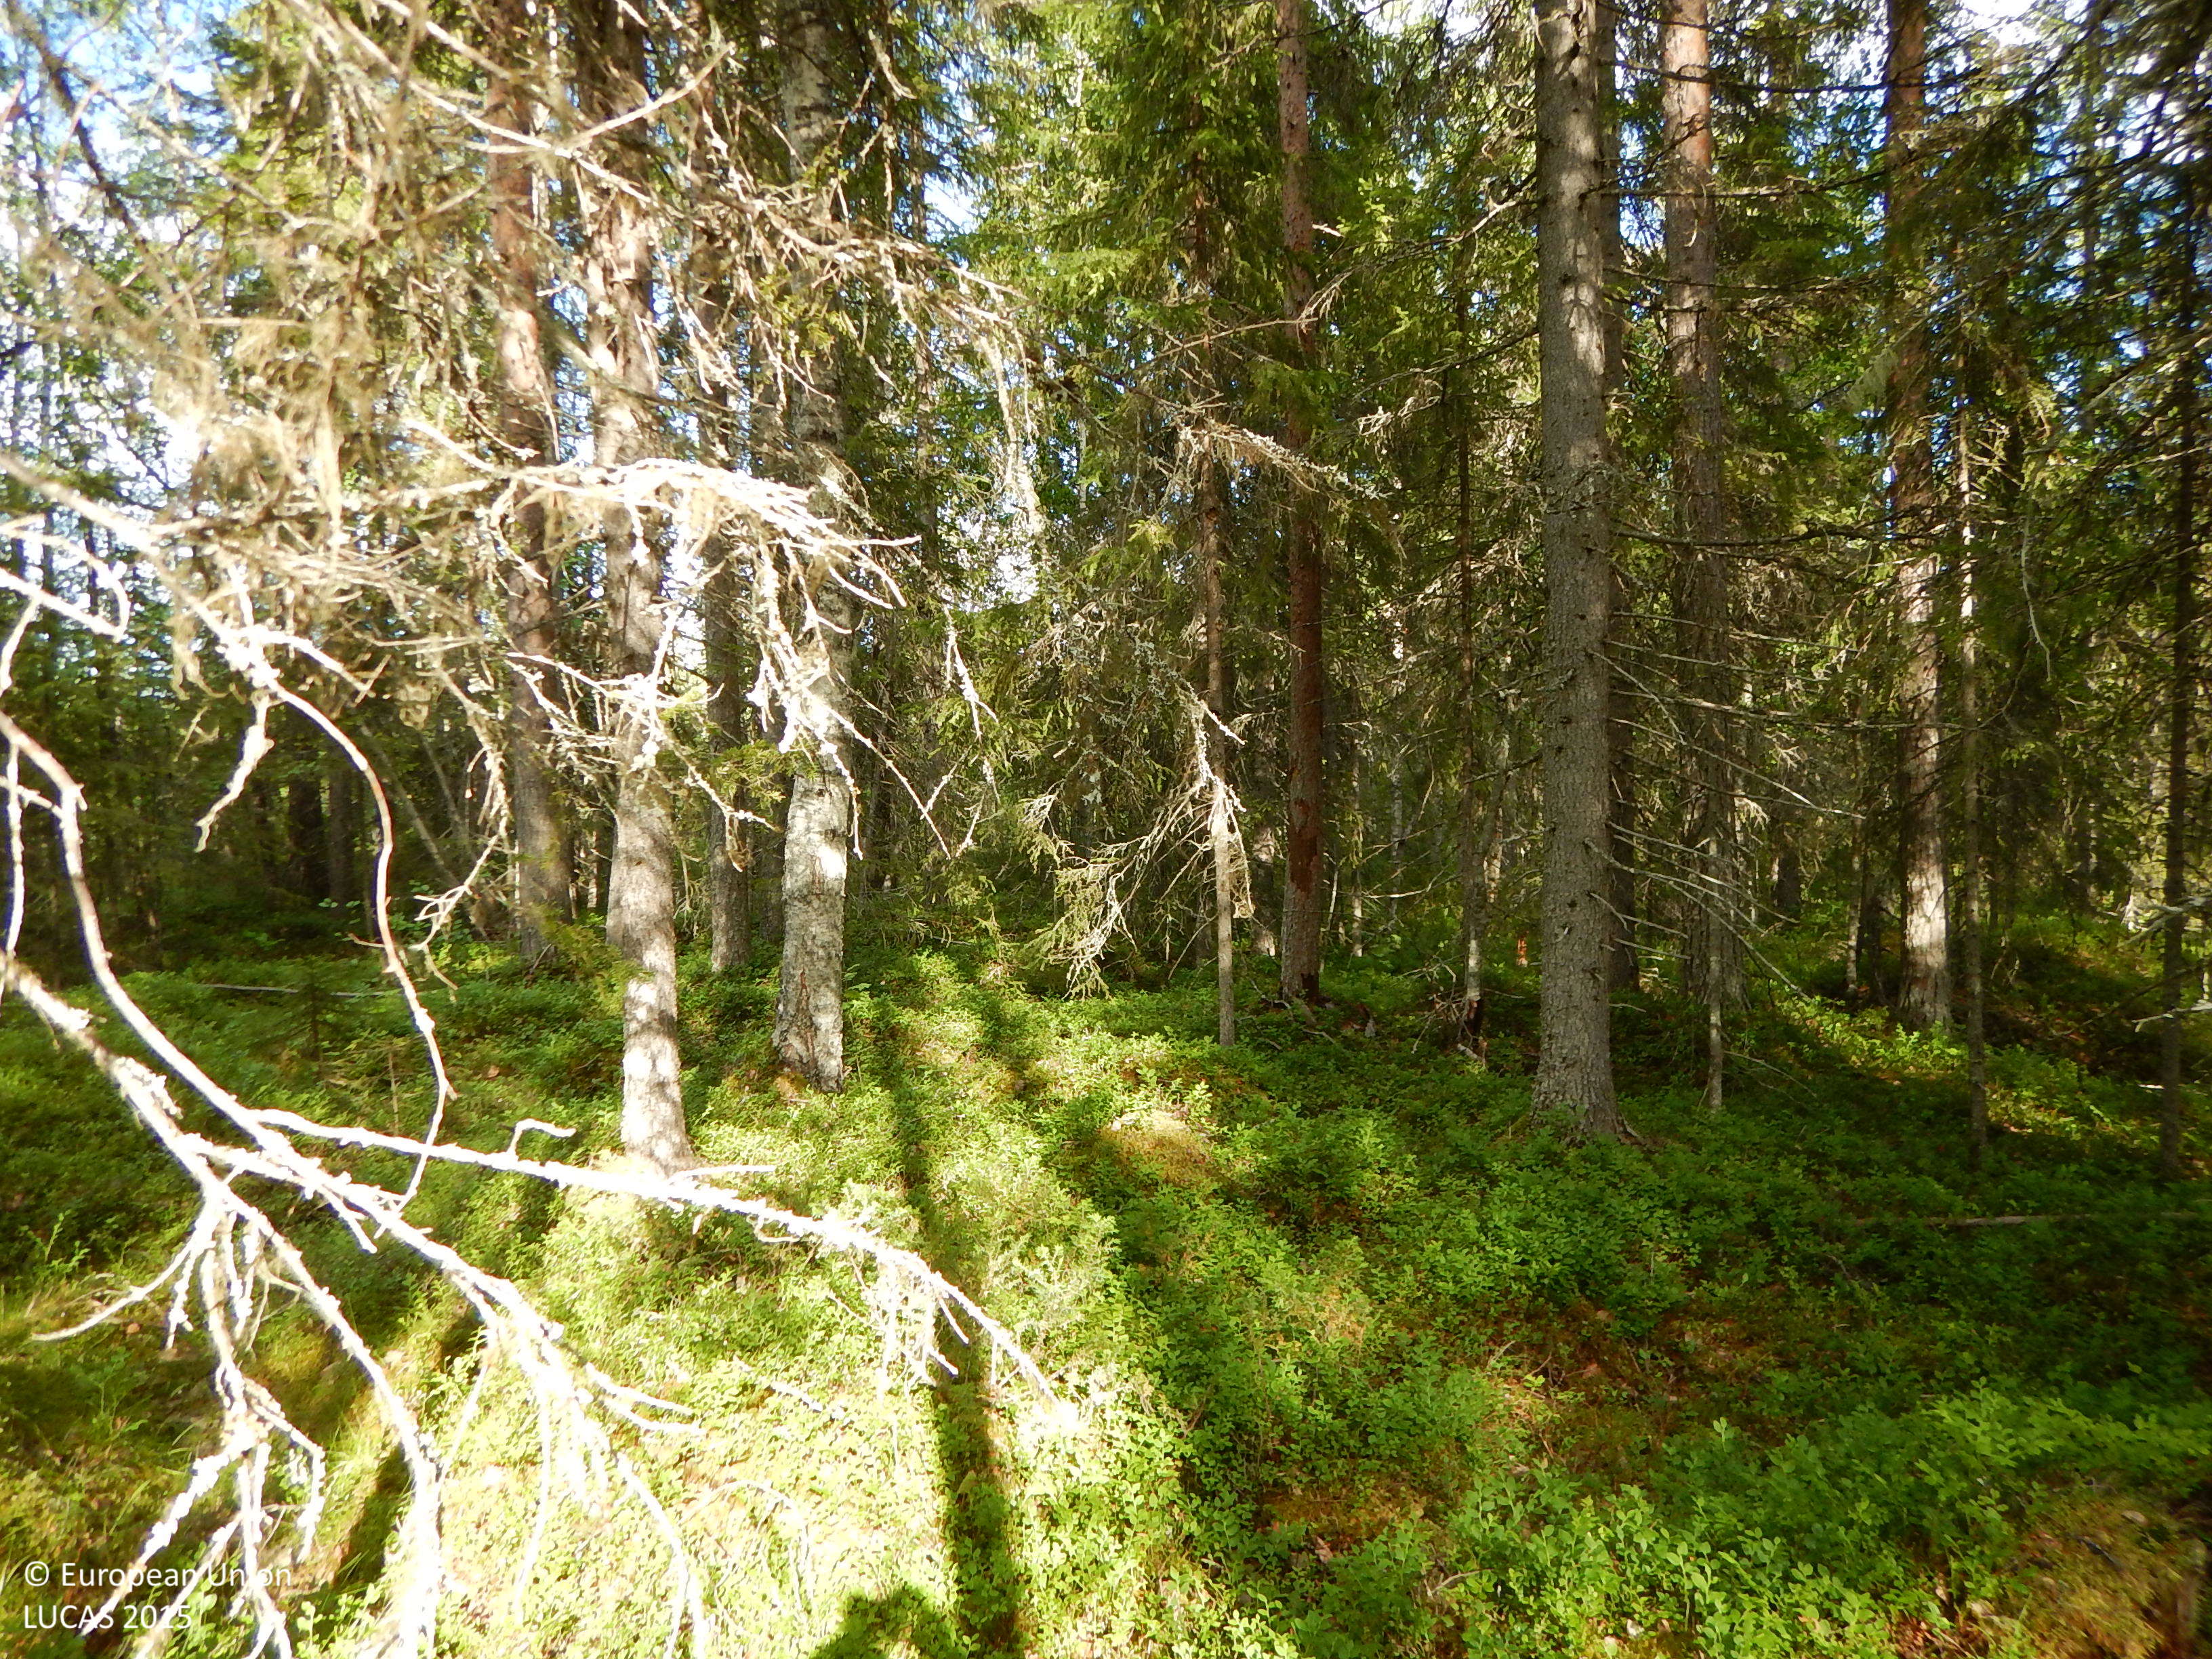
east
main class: Woodland
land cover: Spruce dominated coniferous woodland
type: boreal forest
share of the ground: 50 - 75 %
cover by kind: coniferous forest trees 65 %, shrubs 15 %, lichens and mosses 10 %, broadleaved forest trees 5 %, herbaceous plants 5 %
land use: Forestry
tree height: > 5 m
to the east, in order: Spruce dominated coniferous woodland; Spruce dominated mixed woodland; Pine dominated coniferous woodland
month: July
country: SE
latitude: 64.8249
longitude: 20.3601
